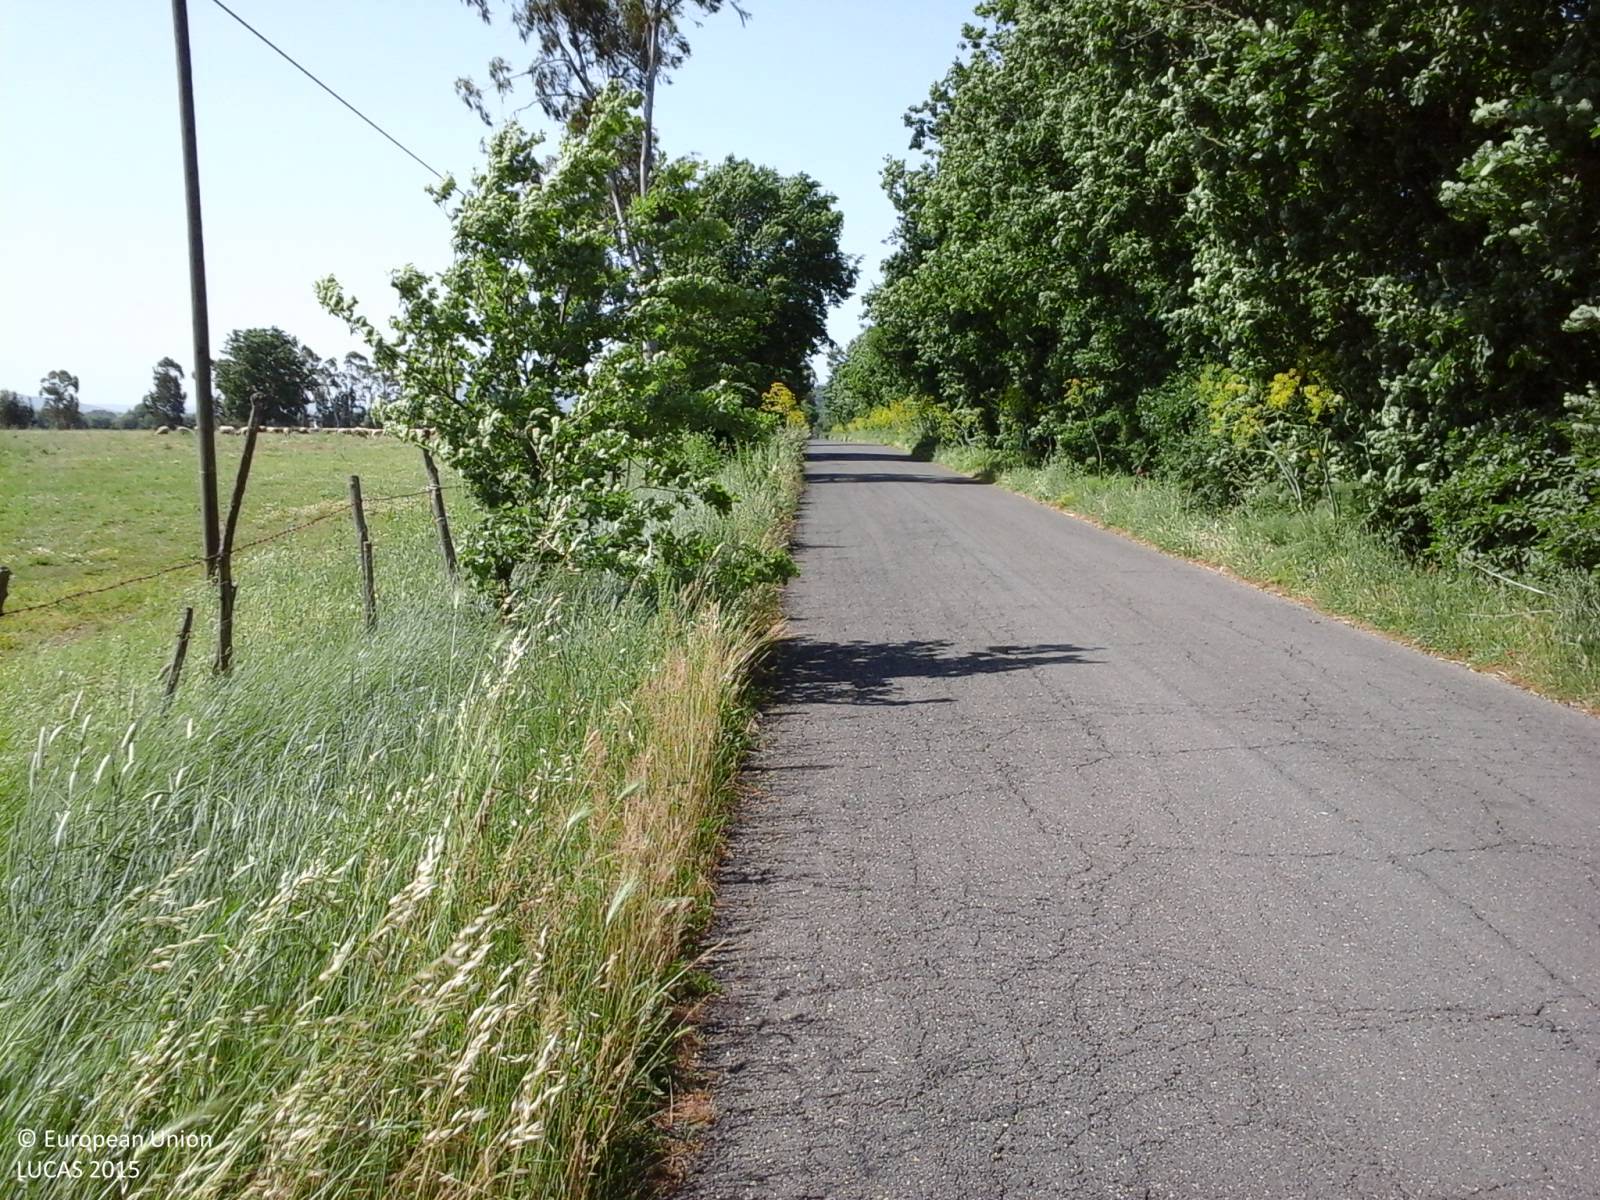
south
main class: Grassland
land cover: Grassland without tree/shrub cover
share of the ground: > 75 %
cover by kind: herbaceous plants 100 %
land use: Agriculture (excluding fallow land and kitchen gardens)
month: May
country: IT
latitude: 42.3096
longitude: 11.9706
